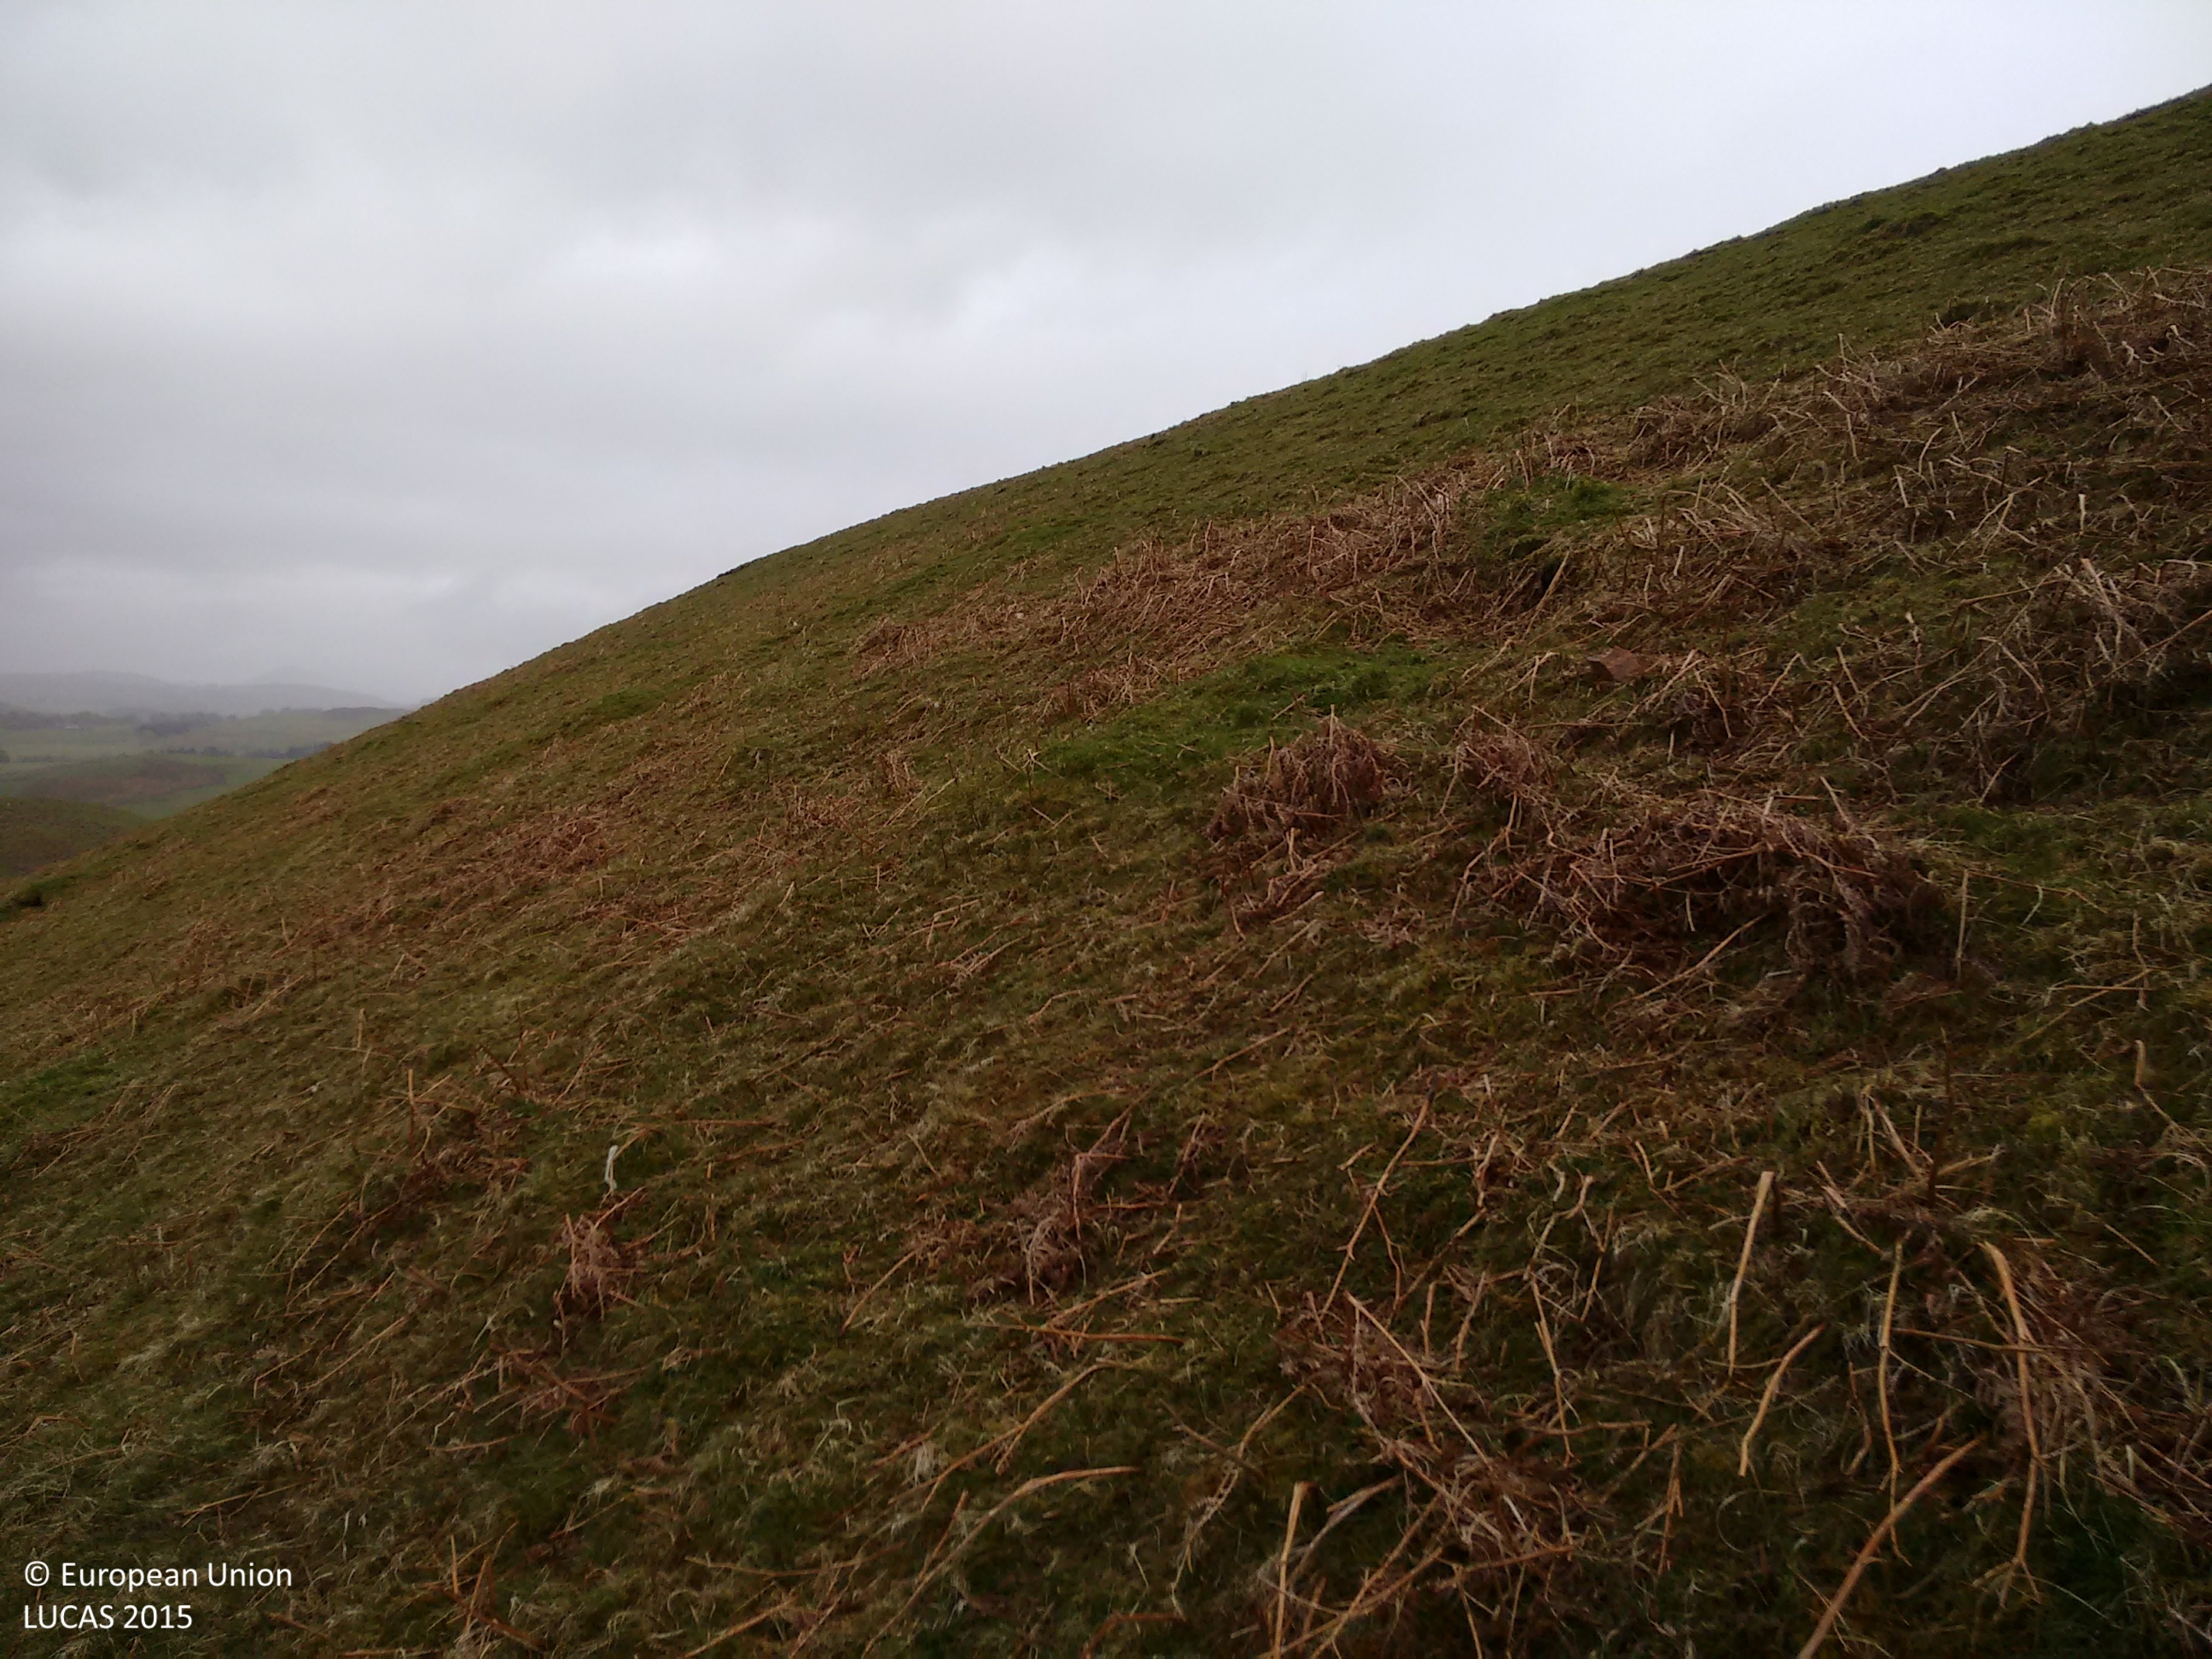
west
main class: Grassland
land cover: Grassland without tree/shrub cover
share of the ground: > 75 %
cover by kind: herbaceous plants 100 %
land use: Agriculture (excluding fallow land and kitchen gardens)
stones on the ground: < 10 %
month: May
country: GB
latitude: 55.8193
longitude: -3.3052
